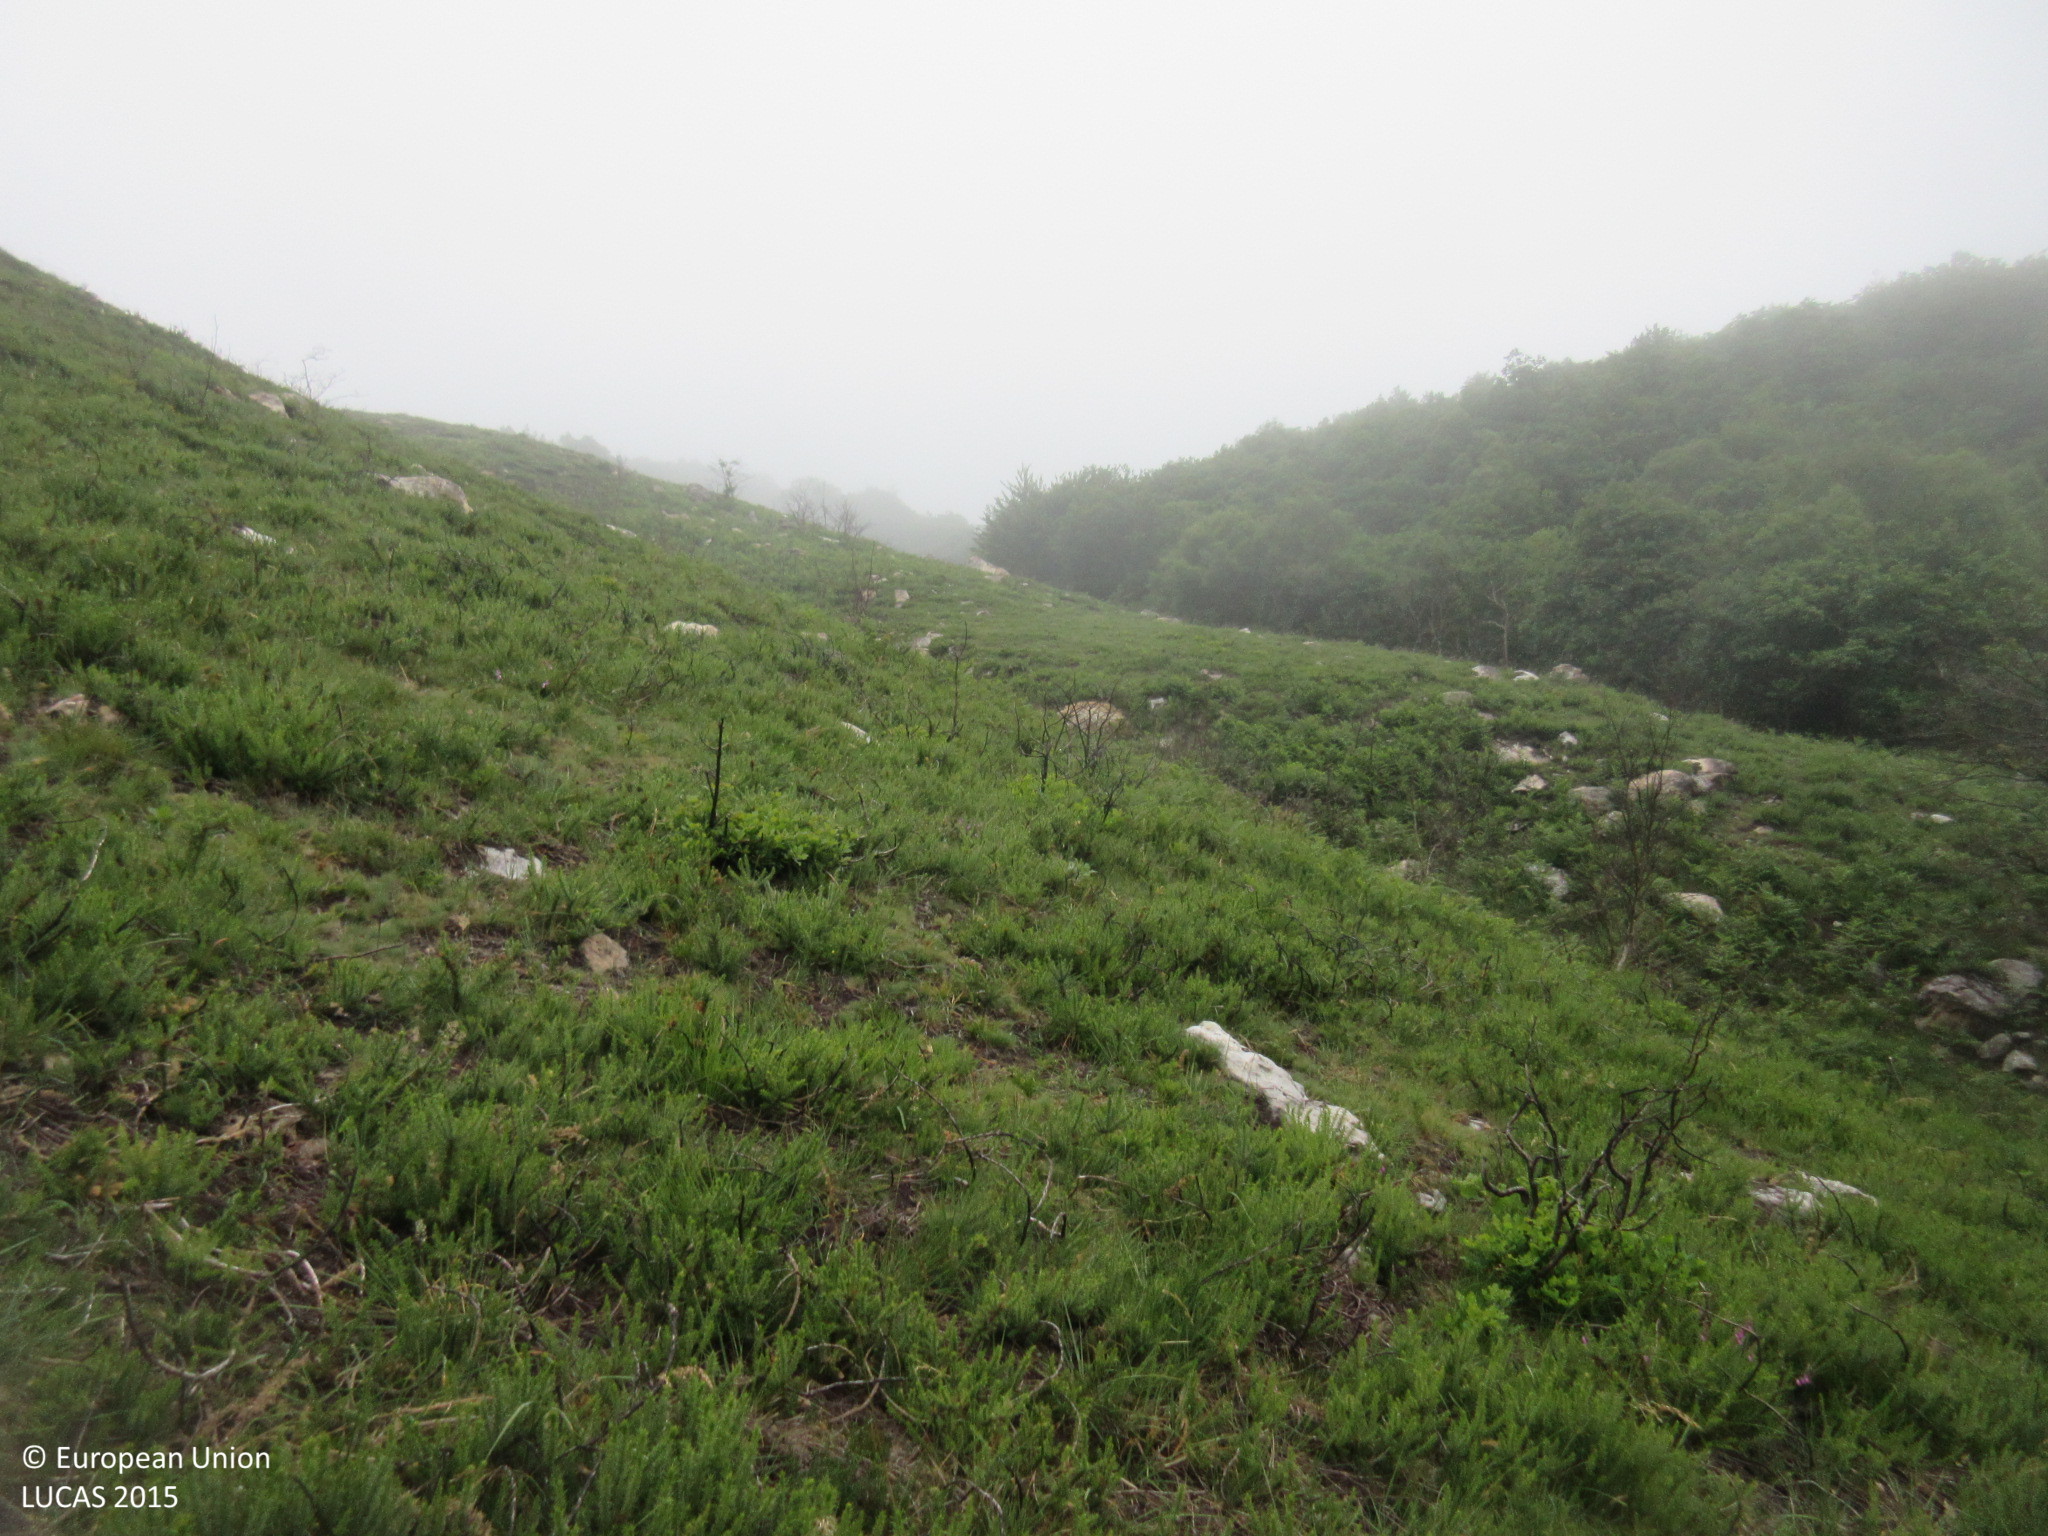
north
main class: Shrubland
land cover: Shrubland without tree cover
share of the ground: > 75 %
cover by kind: shrubs 75 %, herbaceous plants 20 %, unconsolidated bare surface 5 %
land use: Agriculture (excluding fallow land and kitchen gardens)
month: July
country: ES
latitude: 43.0433
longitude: -3.9056
